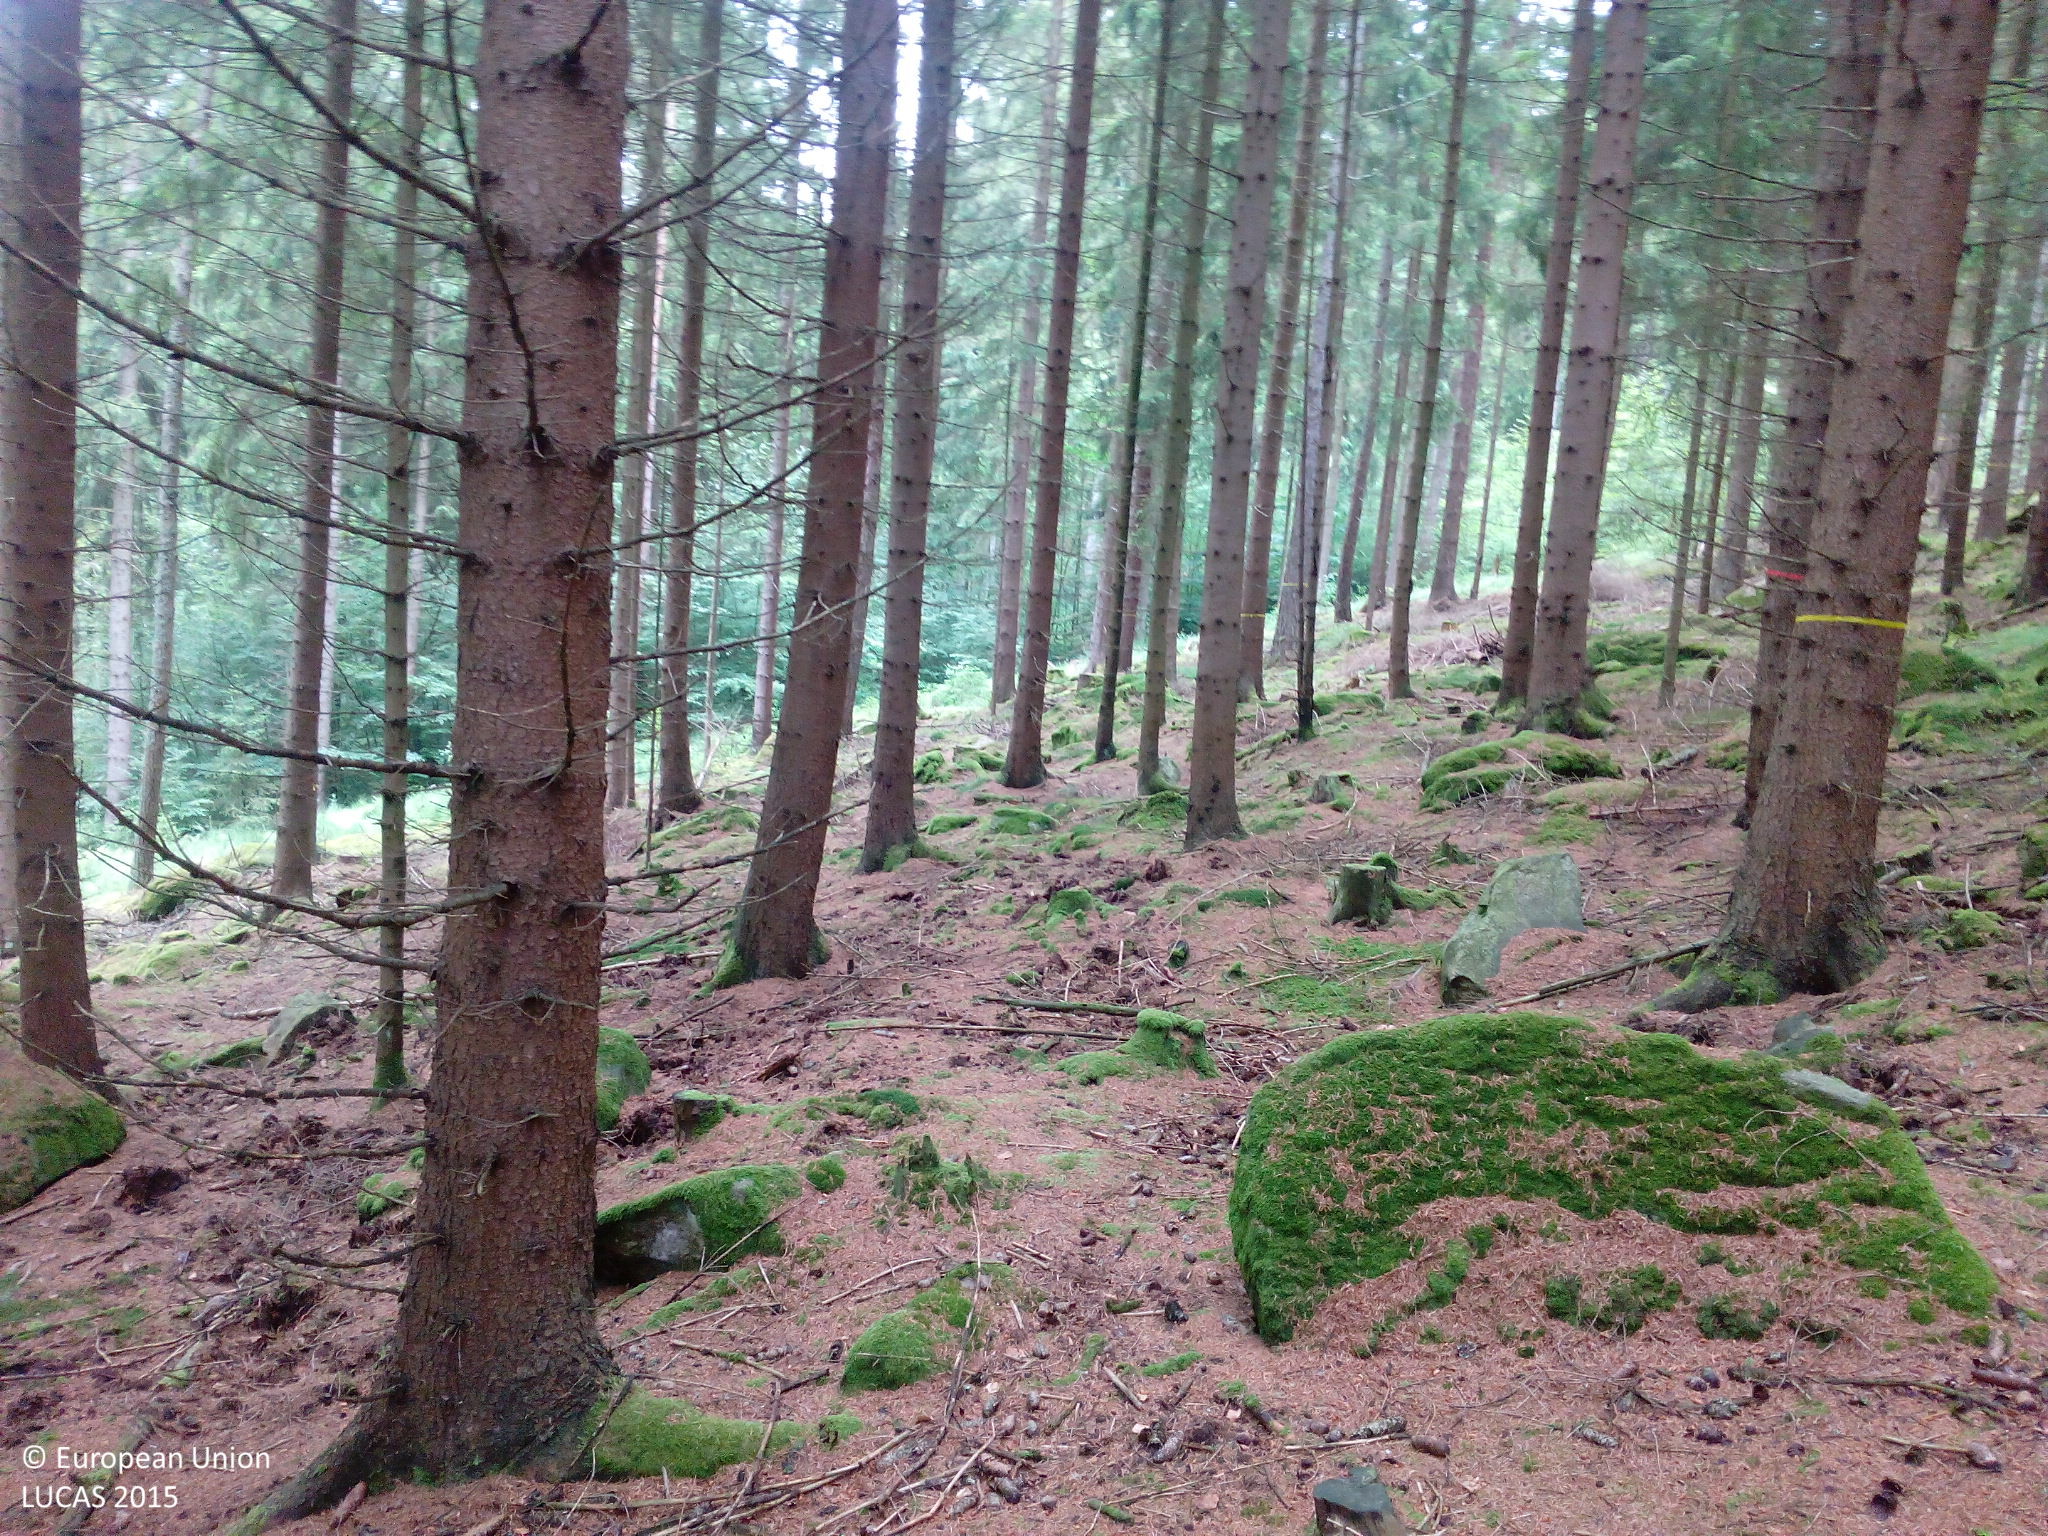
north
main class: Woodland
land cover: Spruce dominated coniferous woodland
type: hemiboreal forest and nemoral coniferous forest and mixed broadleaved-coniferous forest
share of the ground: > 75 %
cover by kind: coniferous forest trees 85 %, lichens and mosses 5 %, consolidated bare surface 5 %, unconsolidated bare surface 5 %
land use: Forestry
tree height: > 5 m
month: June
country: DE
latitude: 49.3851
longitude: 12.4103
